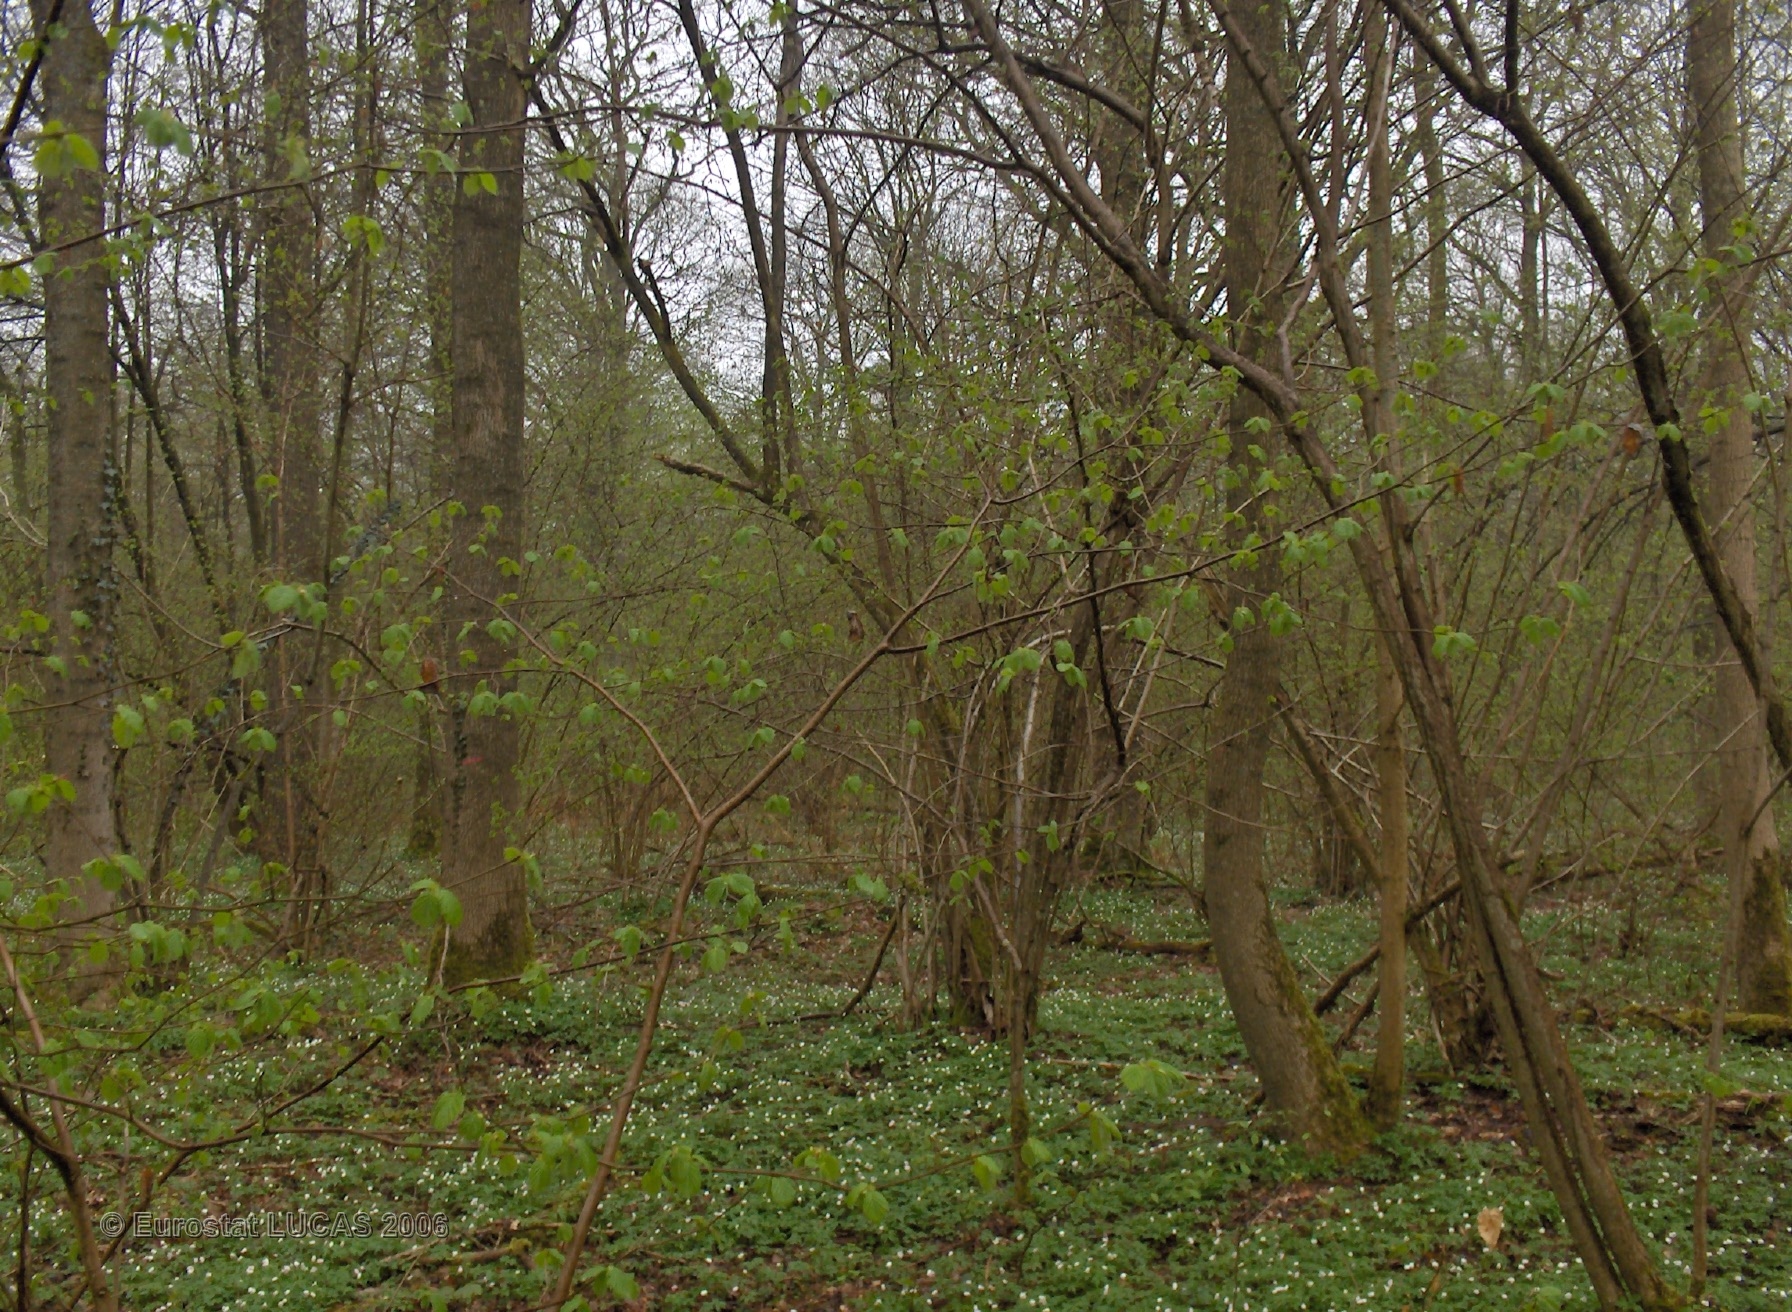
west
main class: Woodland
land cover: Broadleaved forest
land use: Forestry
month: April
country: BE
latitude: 50.2903
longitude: 4.5923
